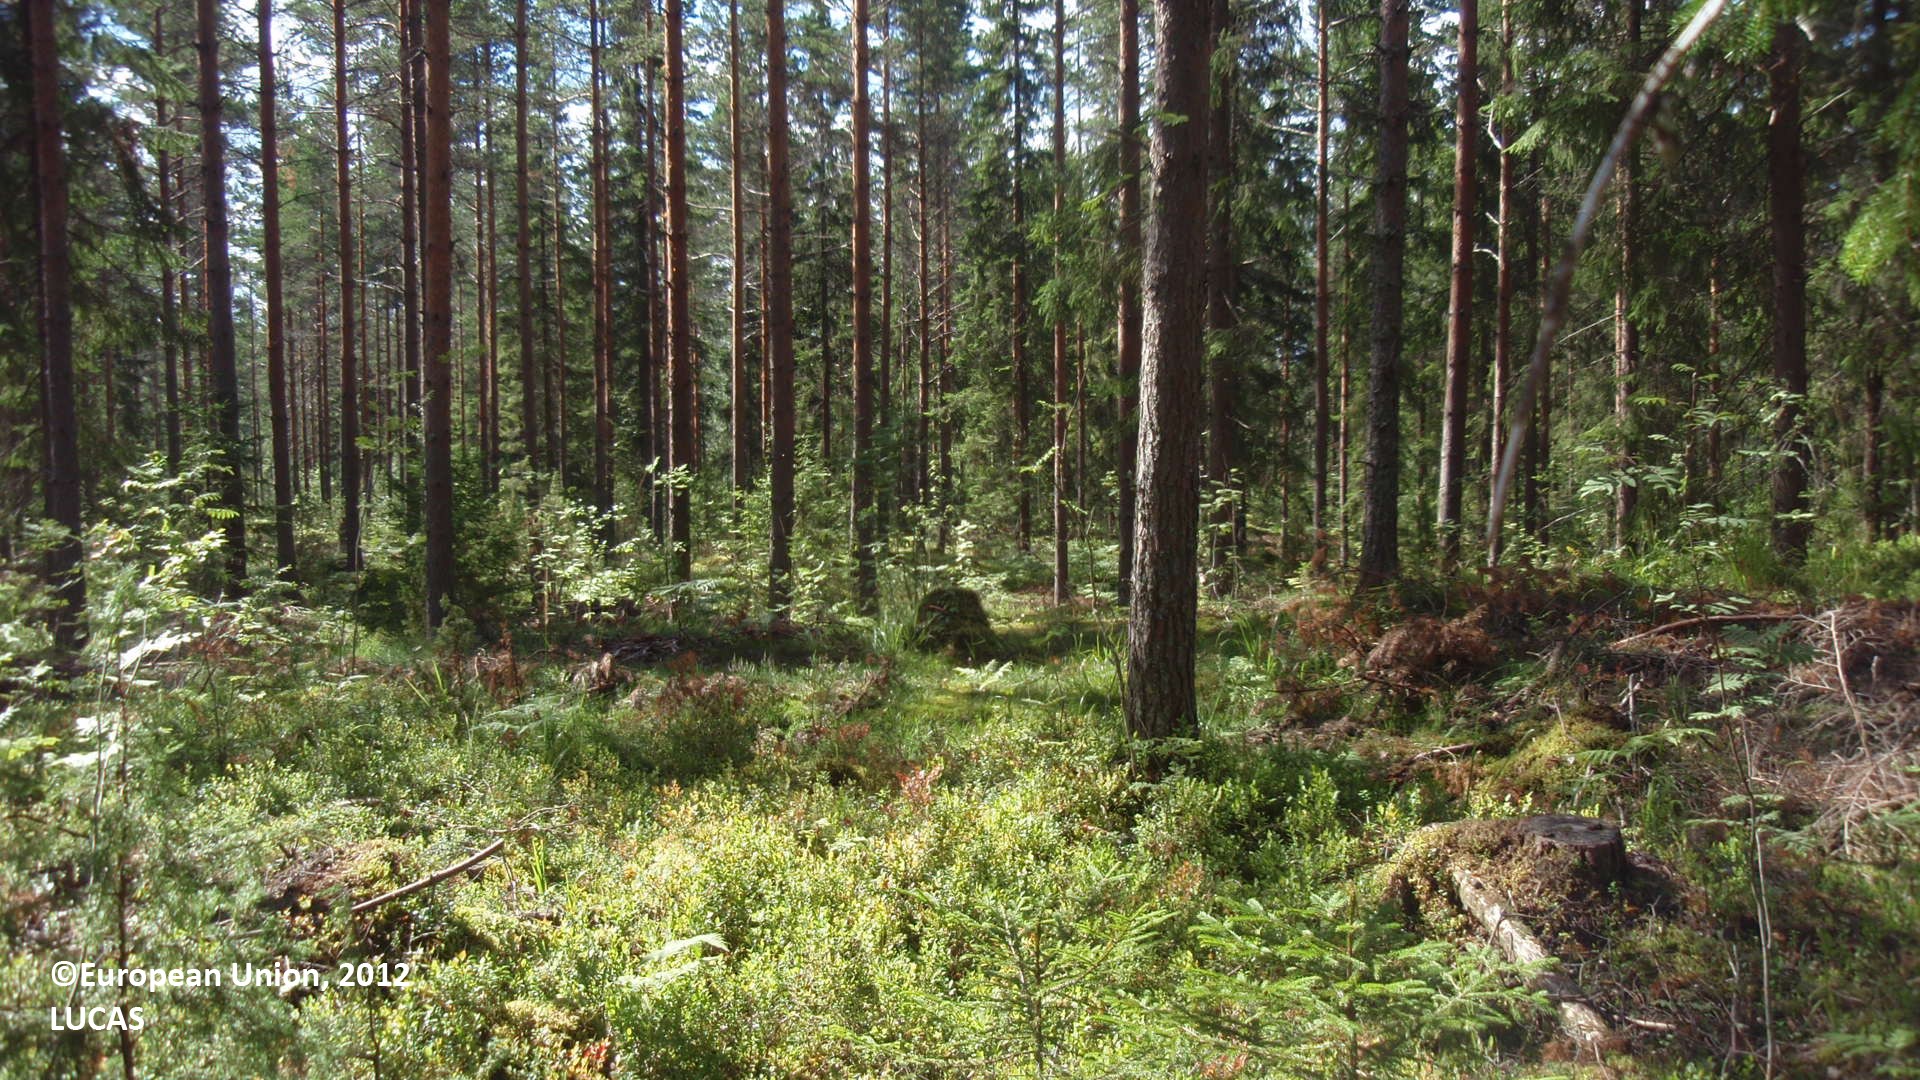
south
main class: Woodland
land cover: Pine dominated coniferous woodland
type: boreal forest
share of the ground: 50 - 75 %
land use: Forestry
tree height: > 5 m
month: August
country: FI
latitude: 61.0831
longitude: 28.0149
